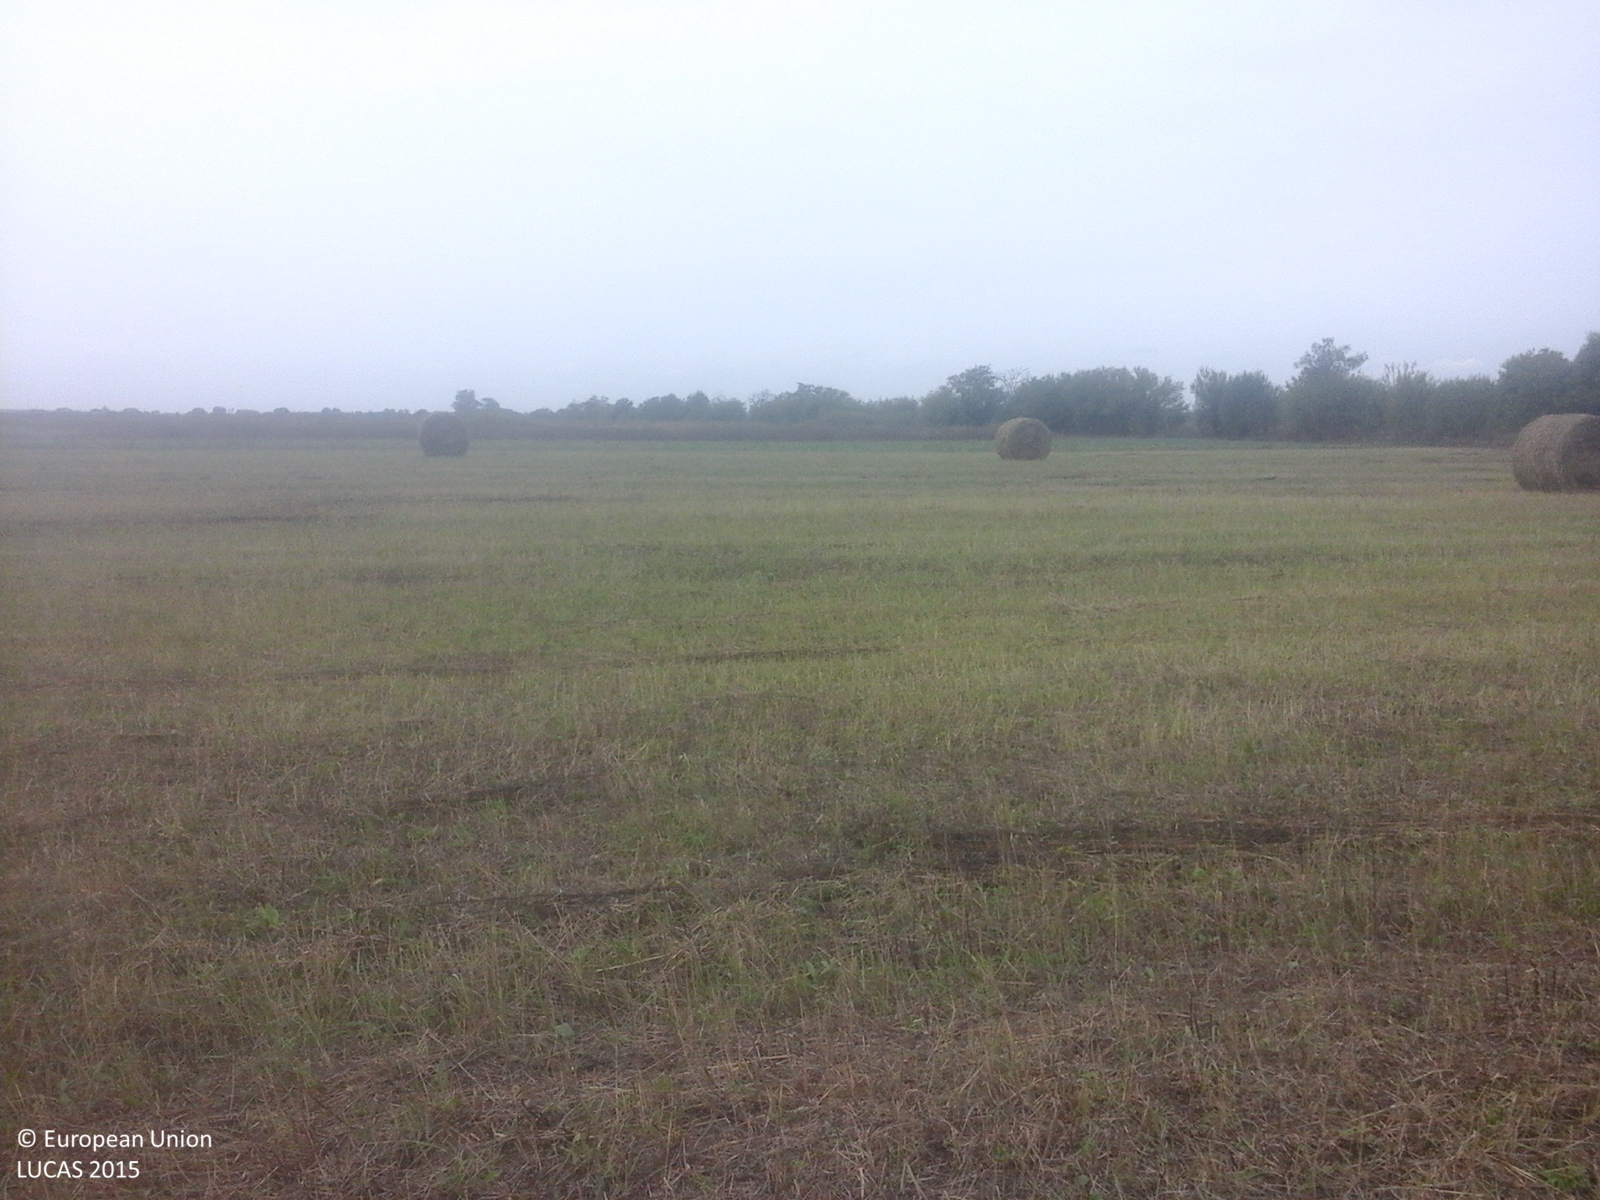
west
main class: Grassland
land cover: Grassland without tree/shrub cover
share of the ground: > 75 %
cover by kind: herbaceous plants 100 %
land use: Agriculture (excluding fallow land and kitchen gardens)
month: September
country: RO
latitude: 45.8398
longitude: 22.1323
